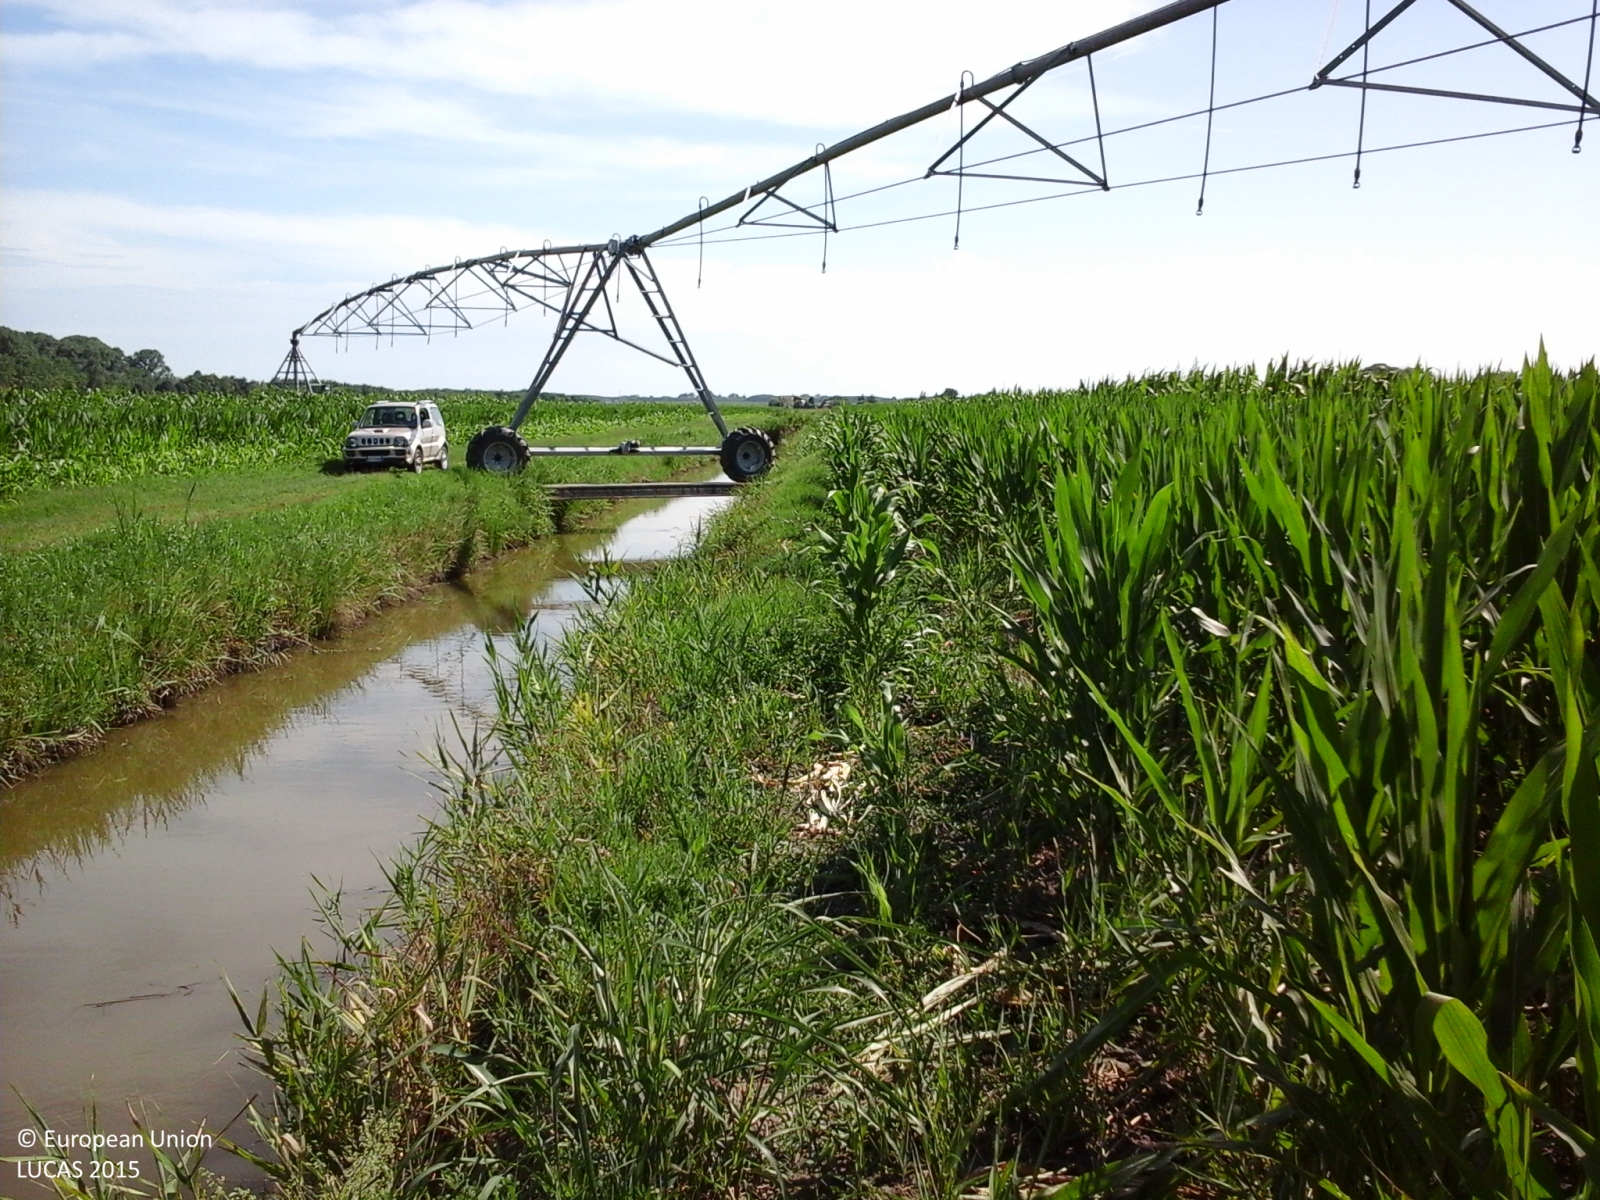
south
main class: Cropland
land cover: Maize
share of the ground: > 75 %
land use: Agriculture (excluding fallow land and kitchen gardens)
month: June
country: IT
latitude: 44.9588
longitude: 12.1891
